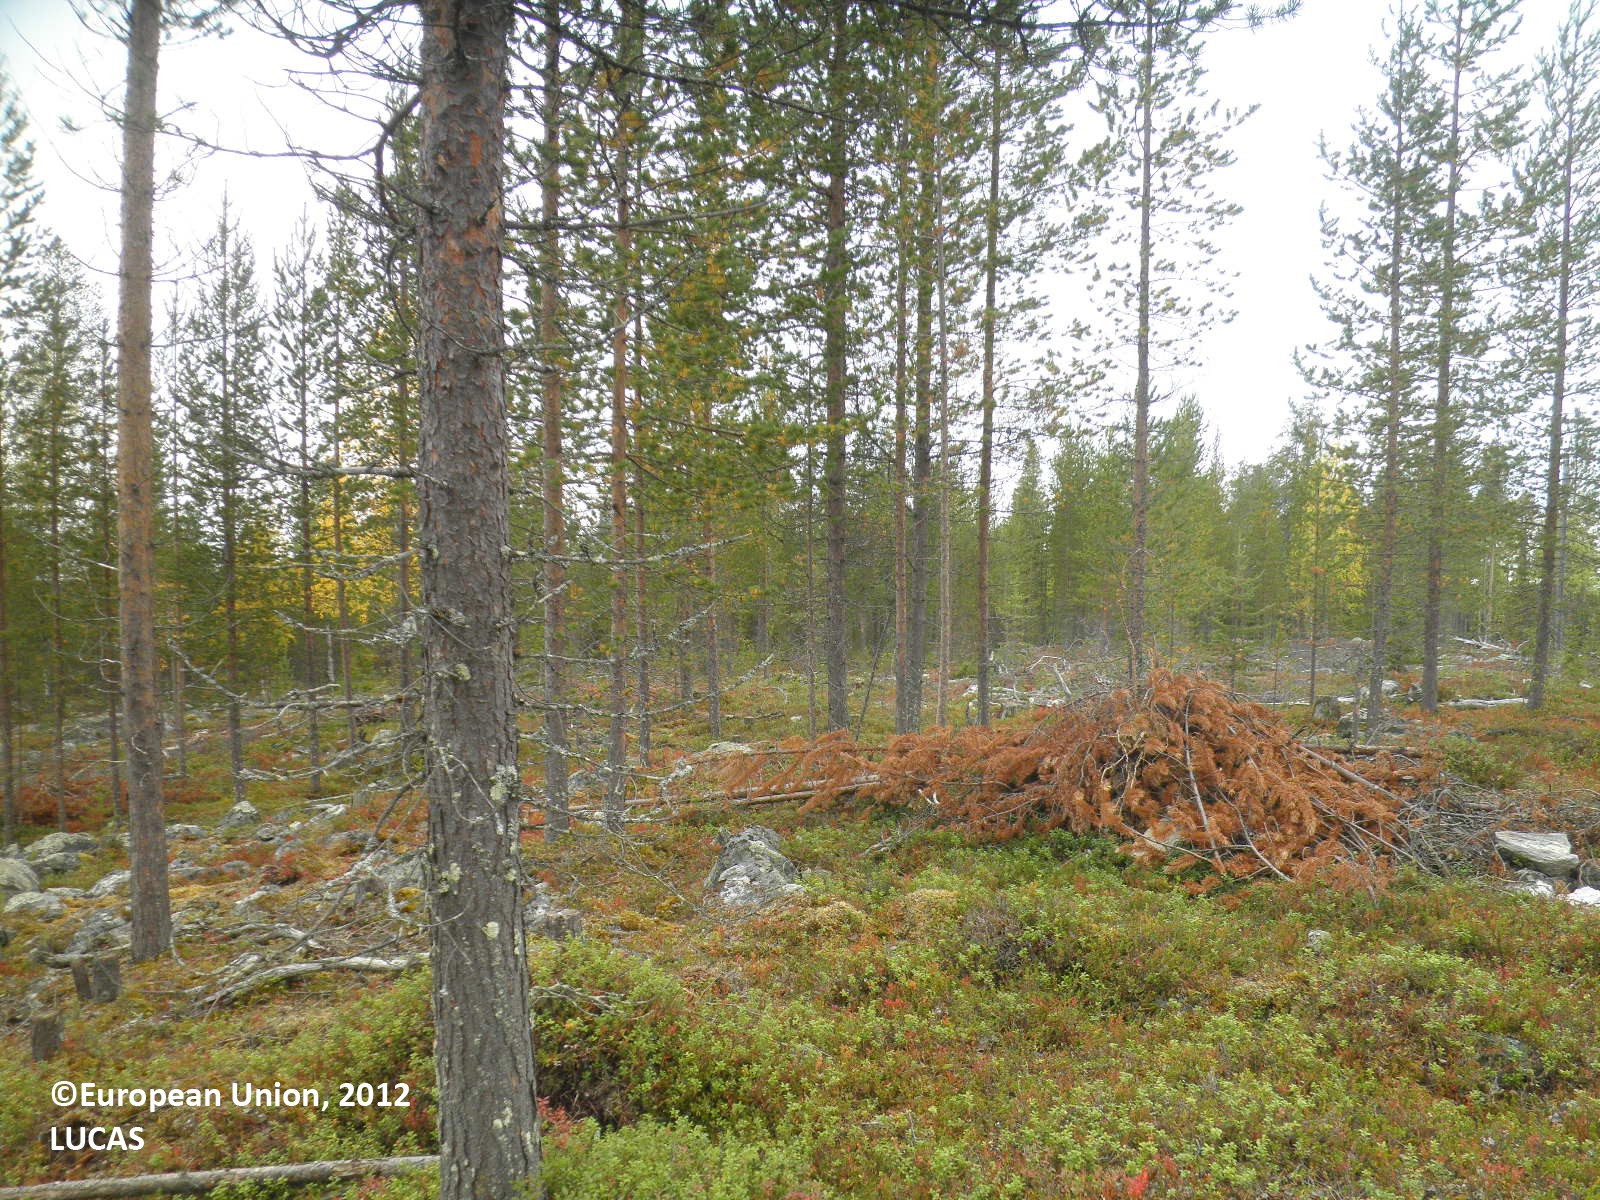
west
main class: Woodland
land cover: Pine dominated coniferous woodland
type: boreal forest
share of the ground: 10 - 25 %
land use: Forestry
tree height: > 5 m
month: September
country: FI
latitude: 67.4335
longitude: 28.6522
